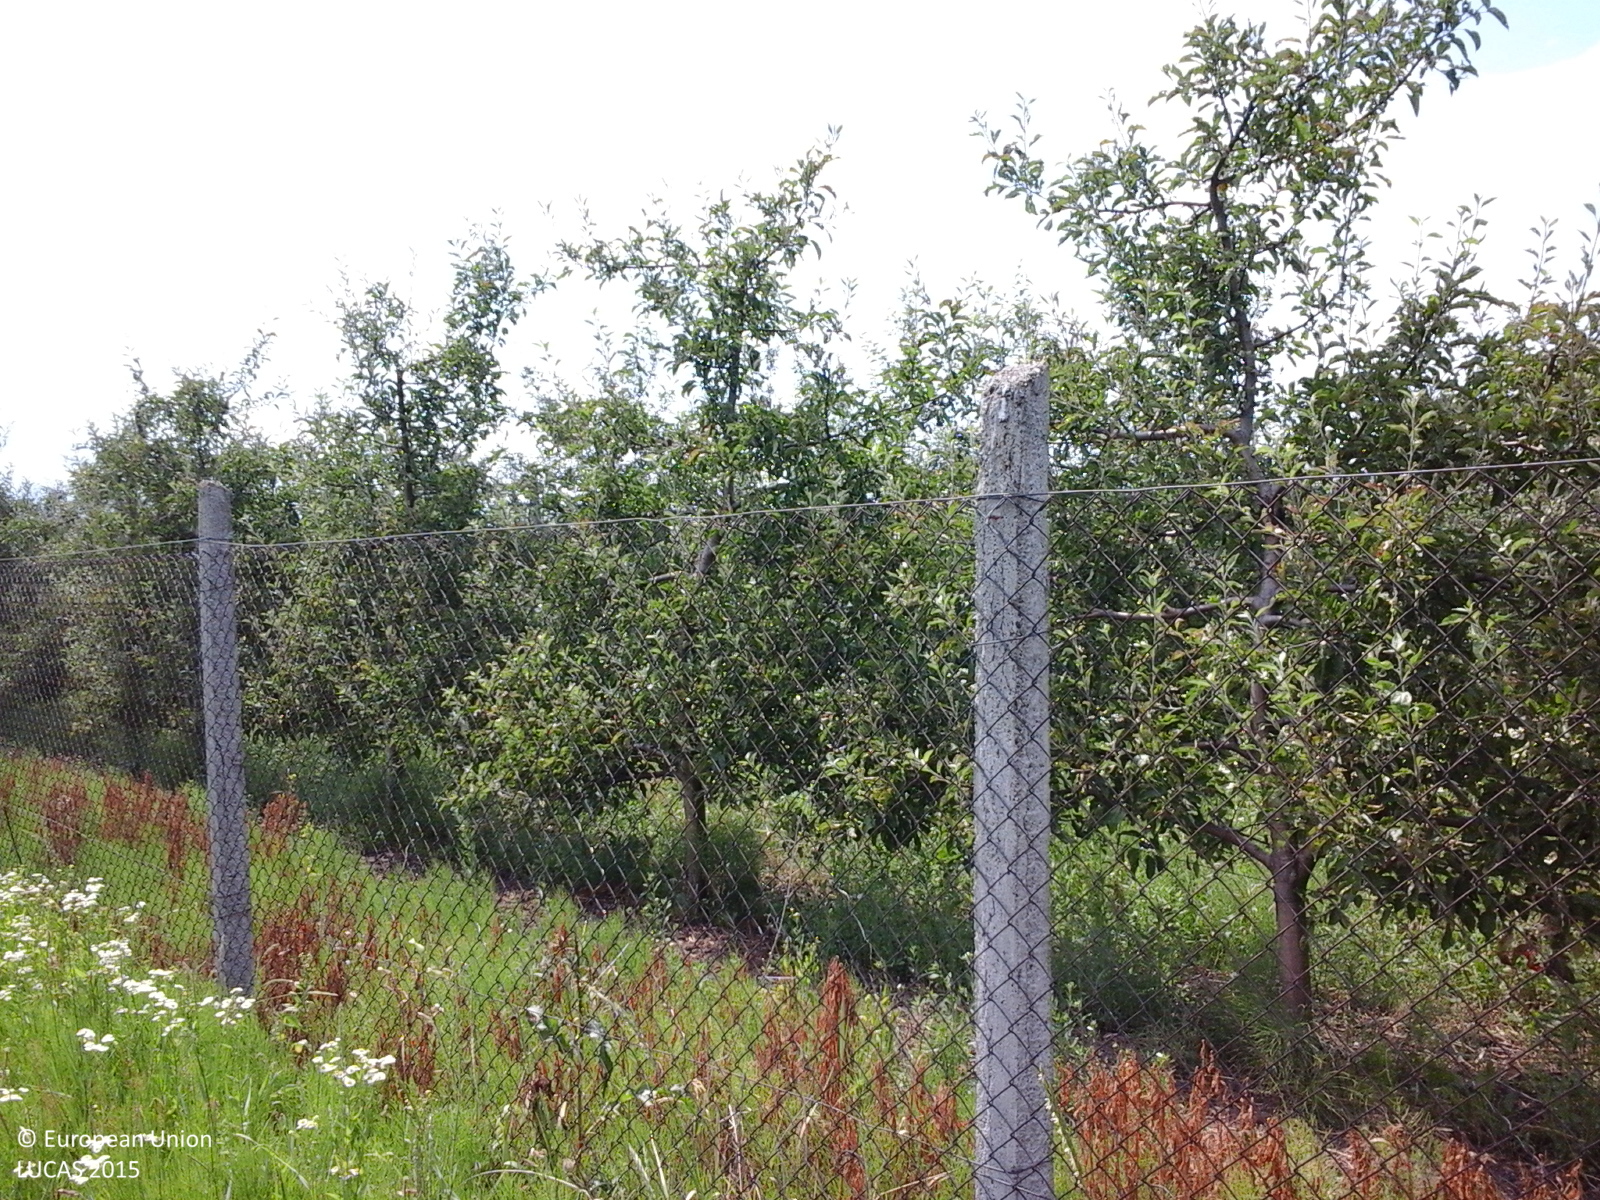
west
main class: Cropland
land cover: Apple fruit
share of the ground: 50 - 75 %
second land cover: Grassland without tree/shrub cover
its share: > 75 %
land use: Agriculture (excluding fallow land and kitchen gardens)
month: June
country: RO
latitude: 47.5179
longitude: 26.2707
